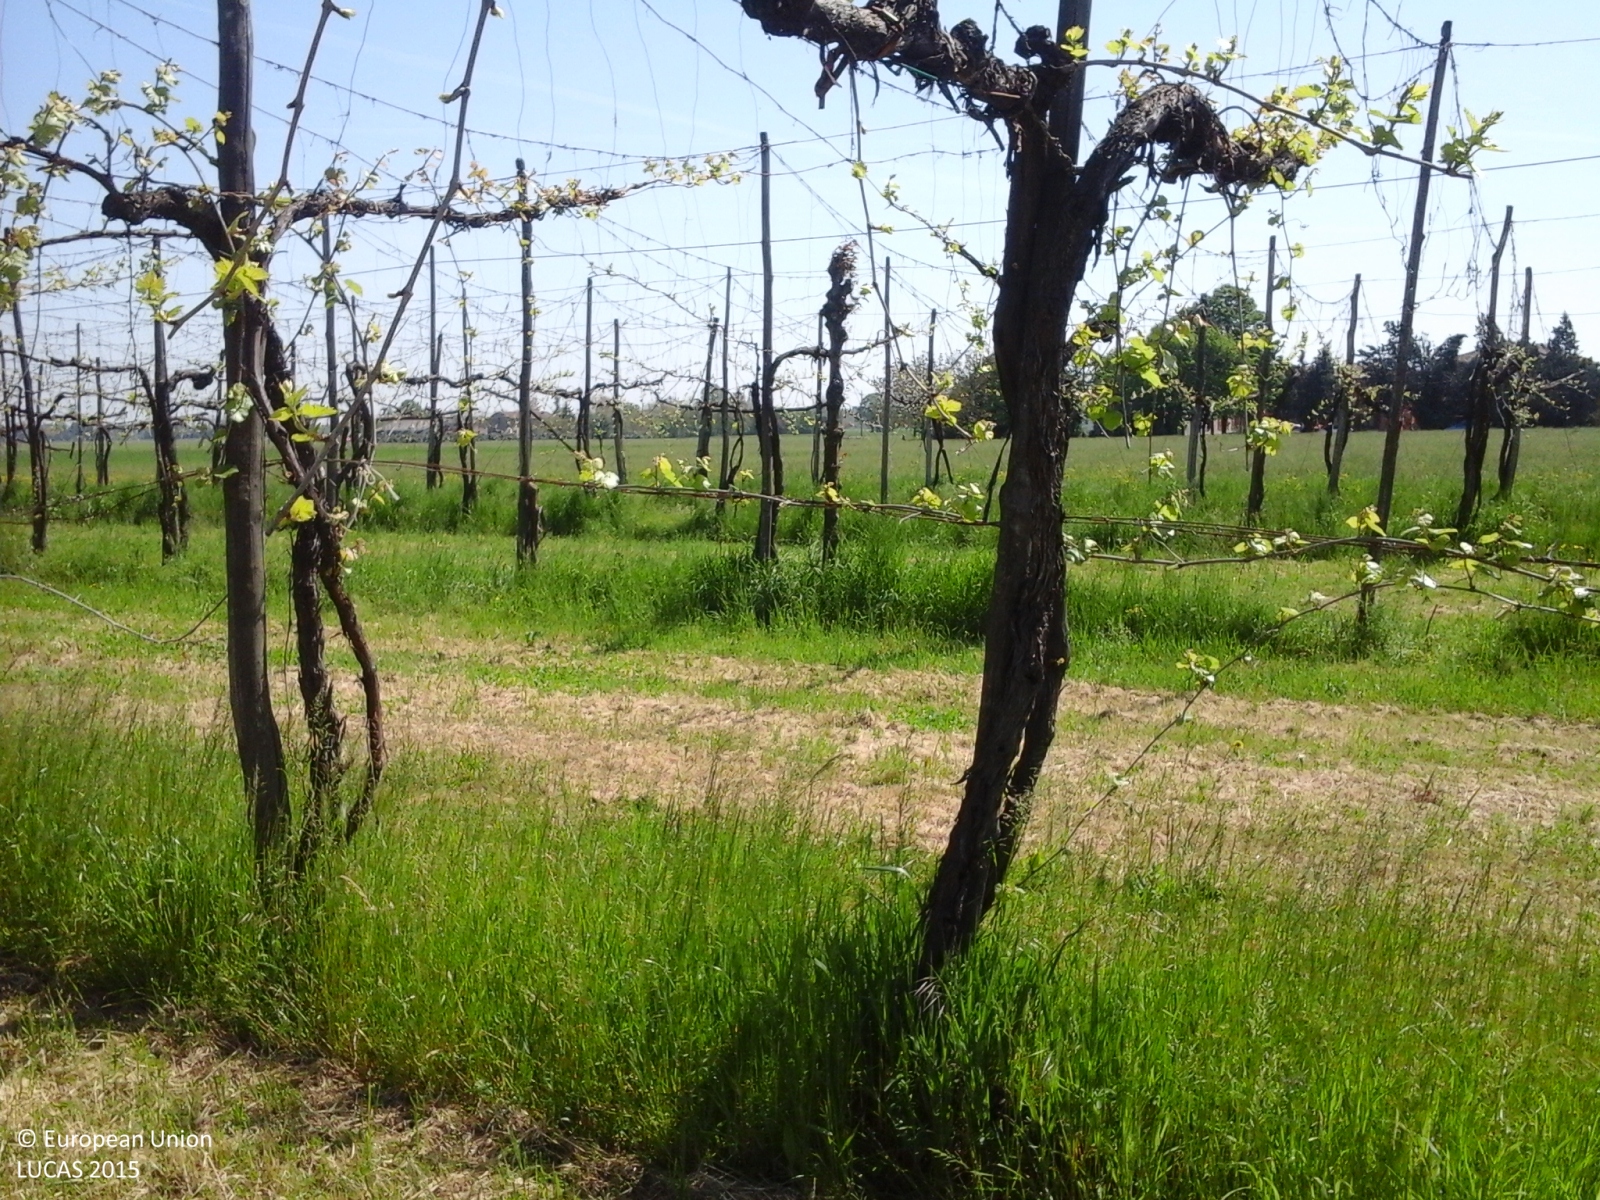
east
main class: Cropland
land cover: Vineyards
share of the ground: 10 - 25 %
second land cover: Spontaneously vegetated surfaces
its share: > 75 %
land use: Agriculture (excluding fallow land and kitchen gardens)
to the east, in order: Vineyards; Spontaneously vegetated surfaces; Temporary grasslands; Grass margins; Other fresh vegetables; Temporary grasslands; Ditches and canals; Tracks; Temporary grasslands
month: April
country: IT
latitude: 44.5812
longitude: 10.8923
